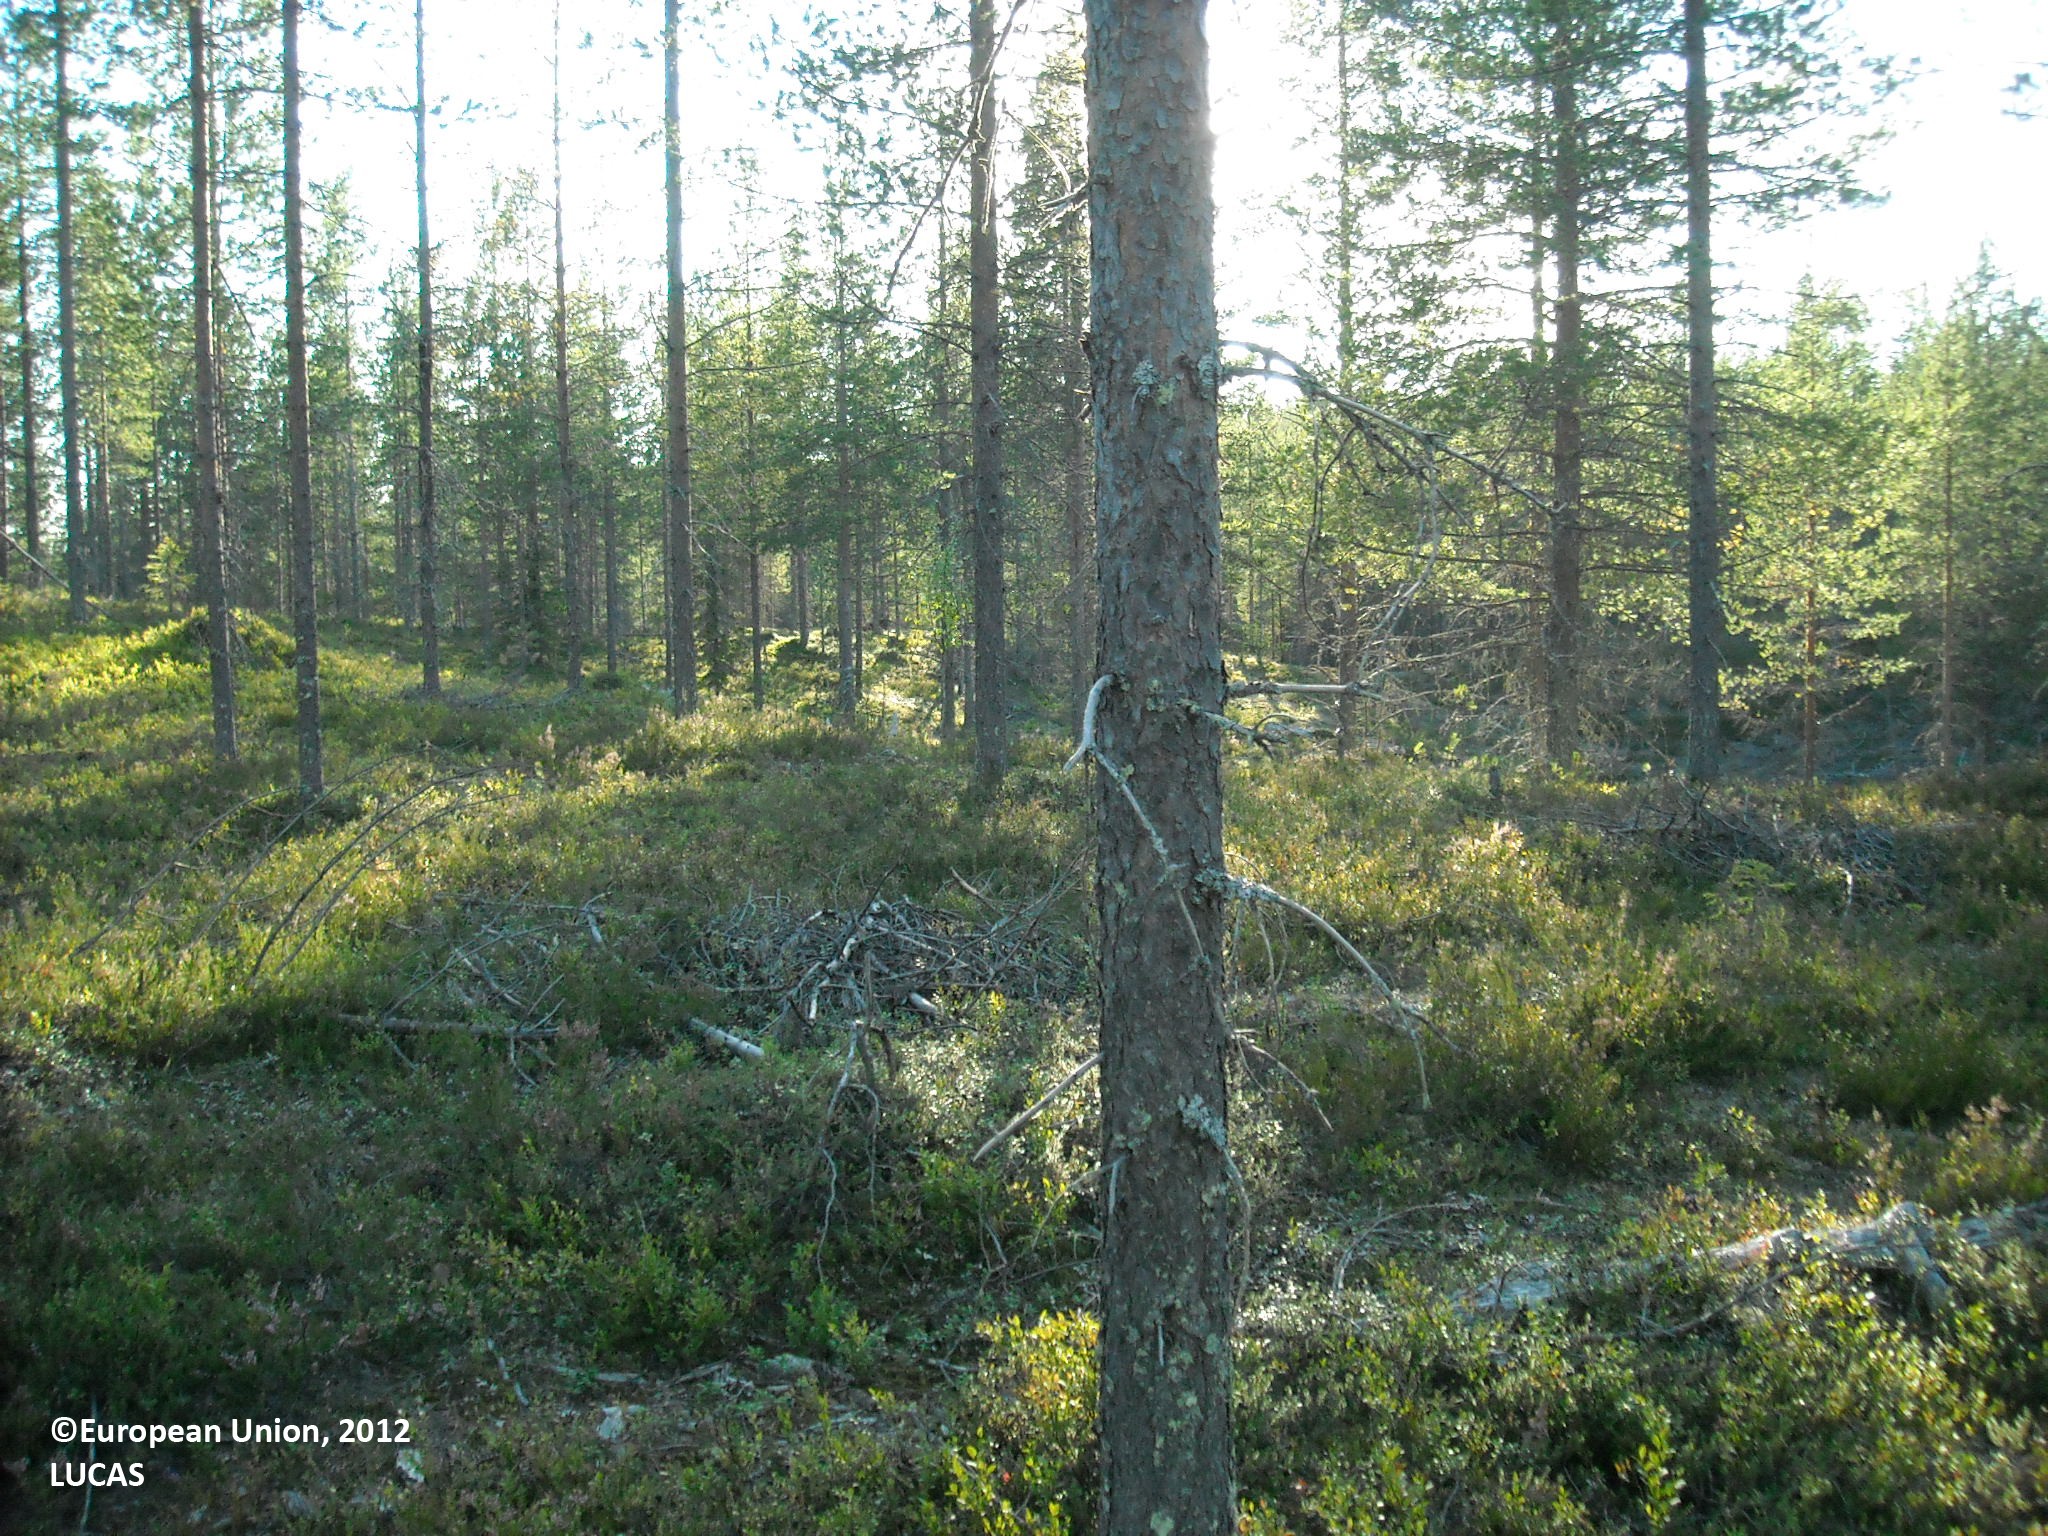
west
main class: Woodland
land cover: Pine dominated coniferous woodland
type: boreal forest
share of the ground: 25 - 50 %
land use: Forestry
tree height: > 5 m
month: August
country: FI
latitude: 65.4692
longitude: 27.7738
